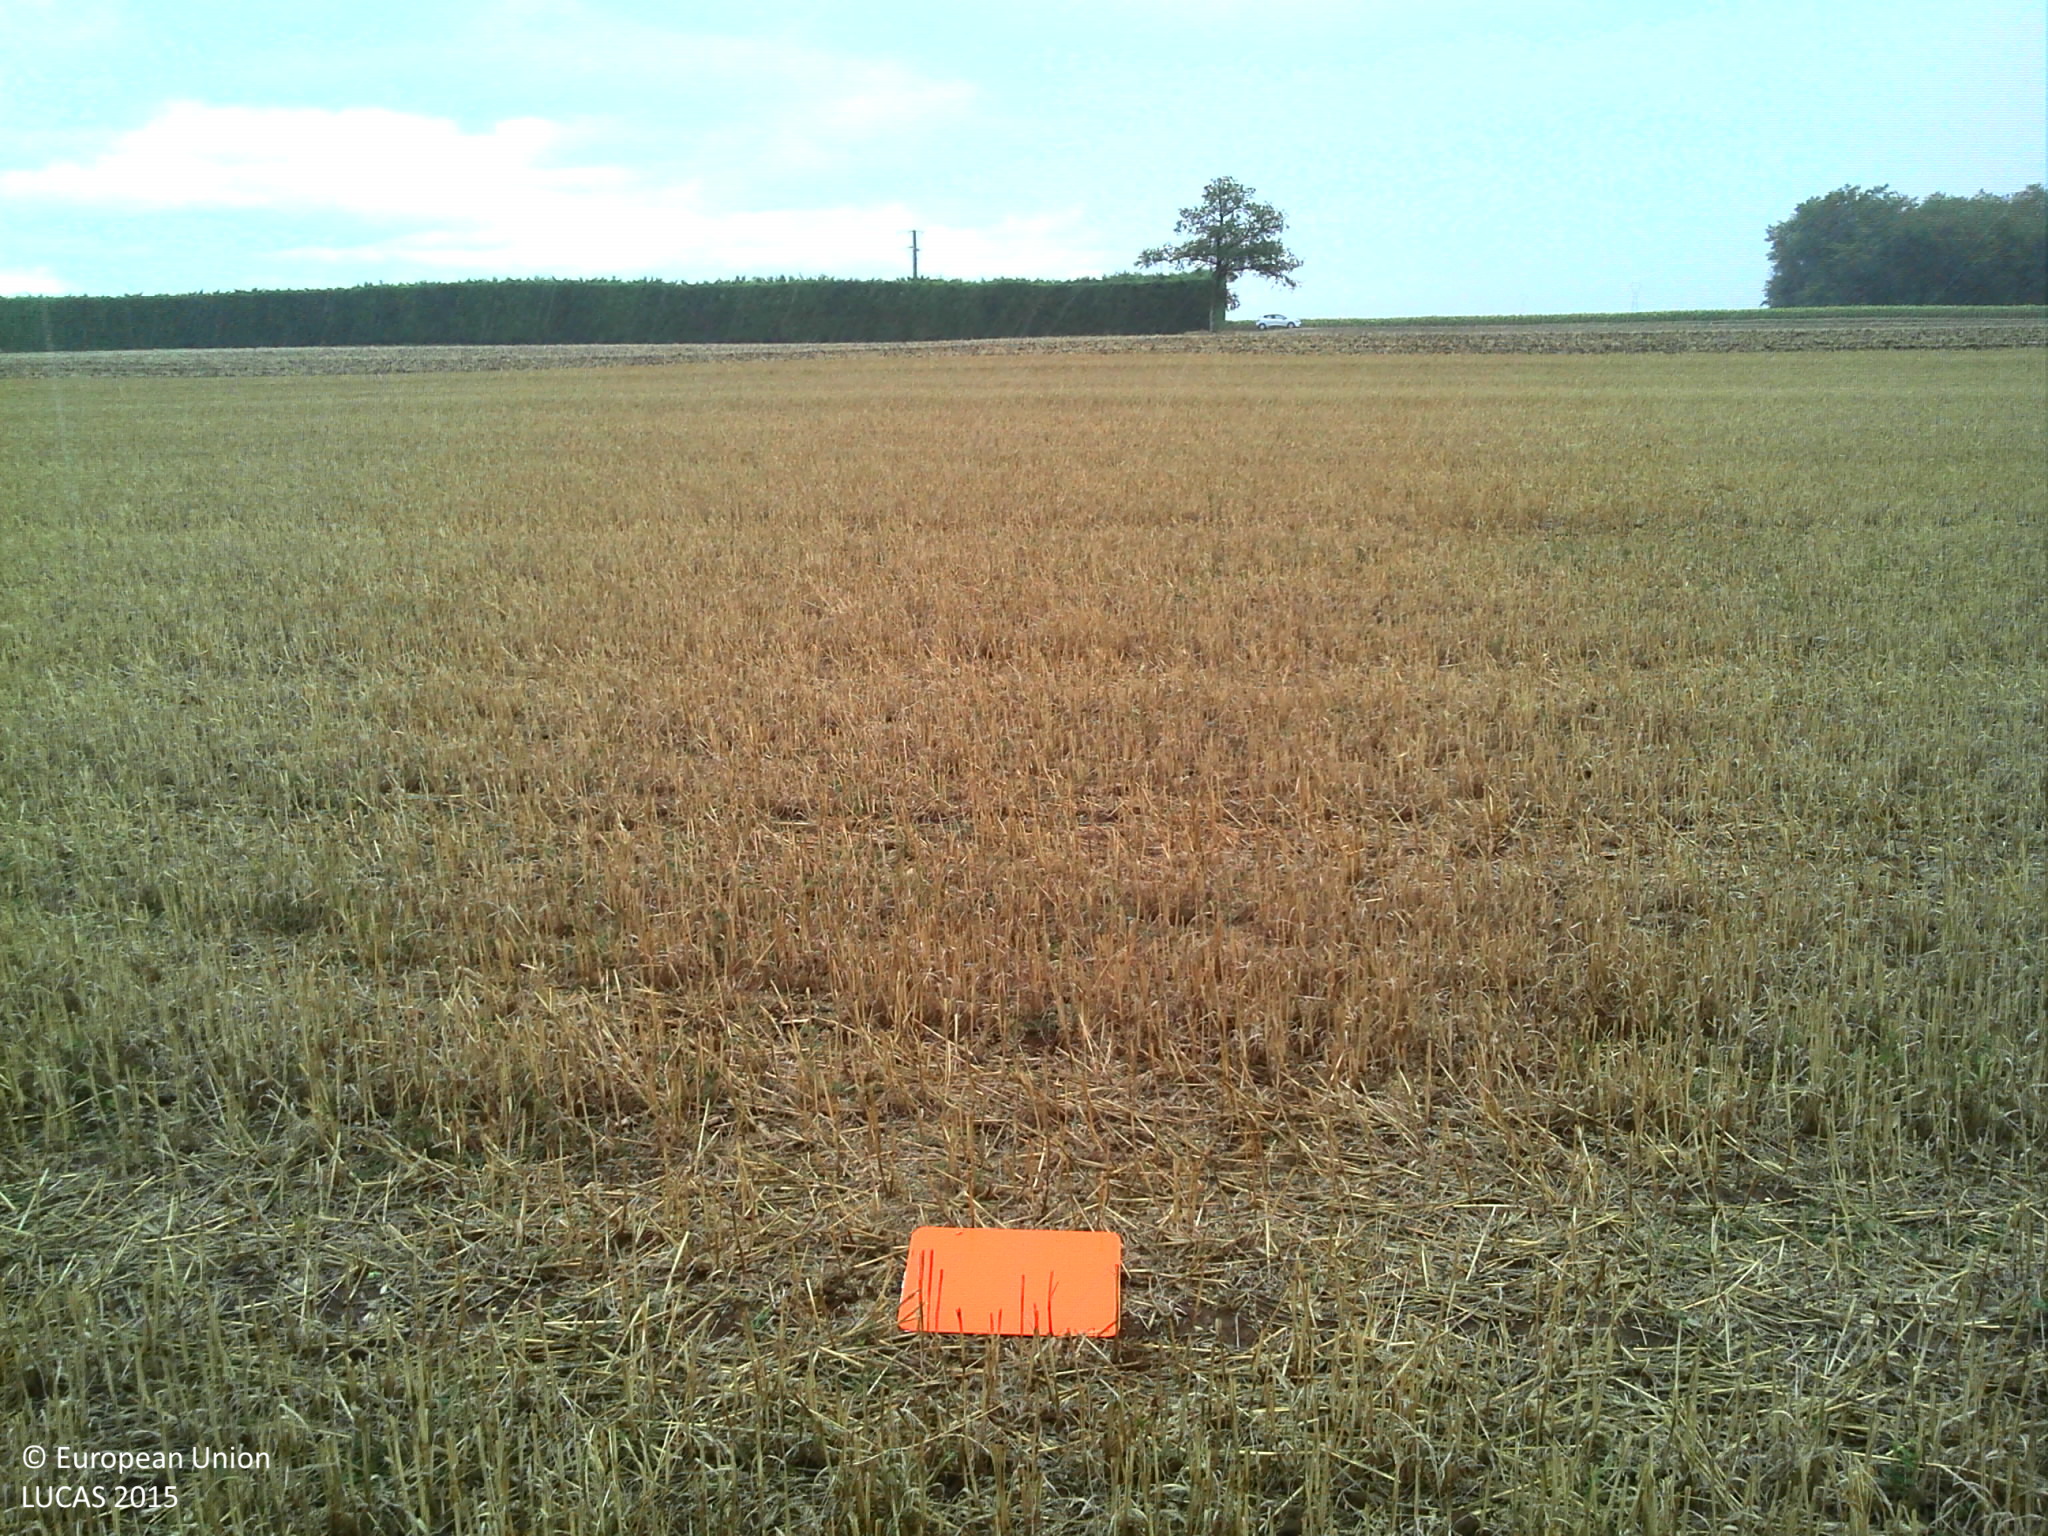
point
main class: Cropland
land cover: Common wheat
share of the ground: < 10 %
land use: Agriculture (excluding fallow land and kitchen gardens)
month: August
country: FR
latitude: 46.7478
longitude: 0.1481
